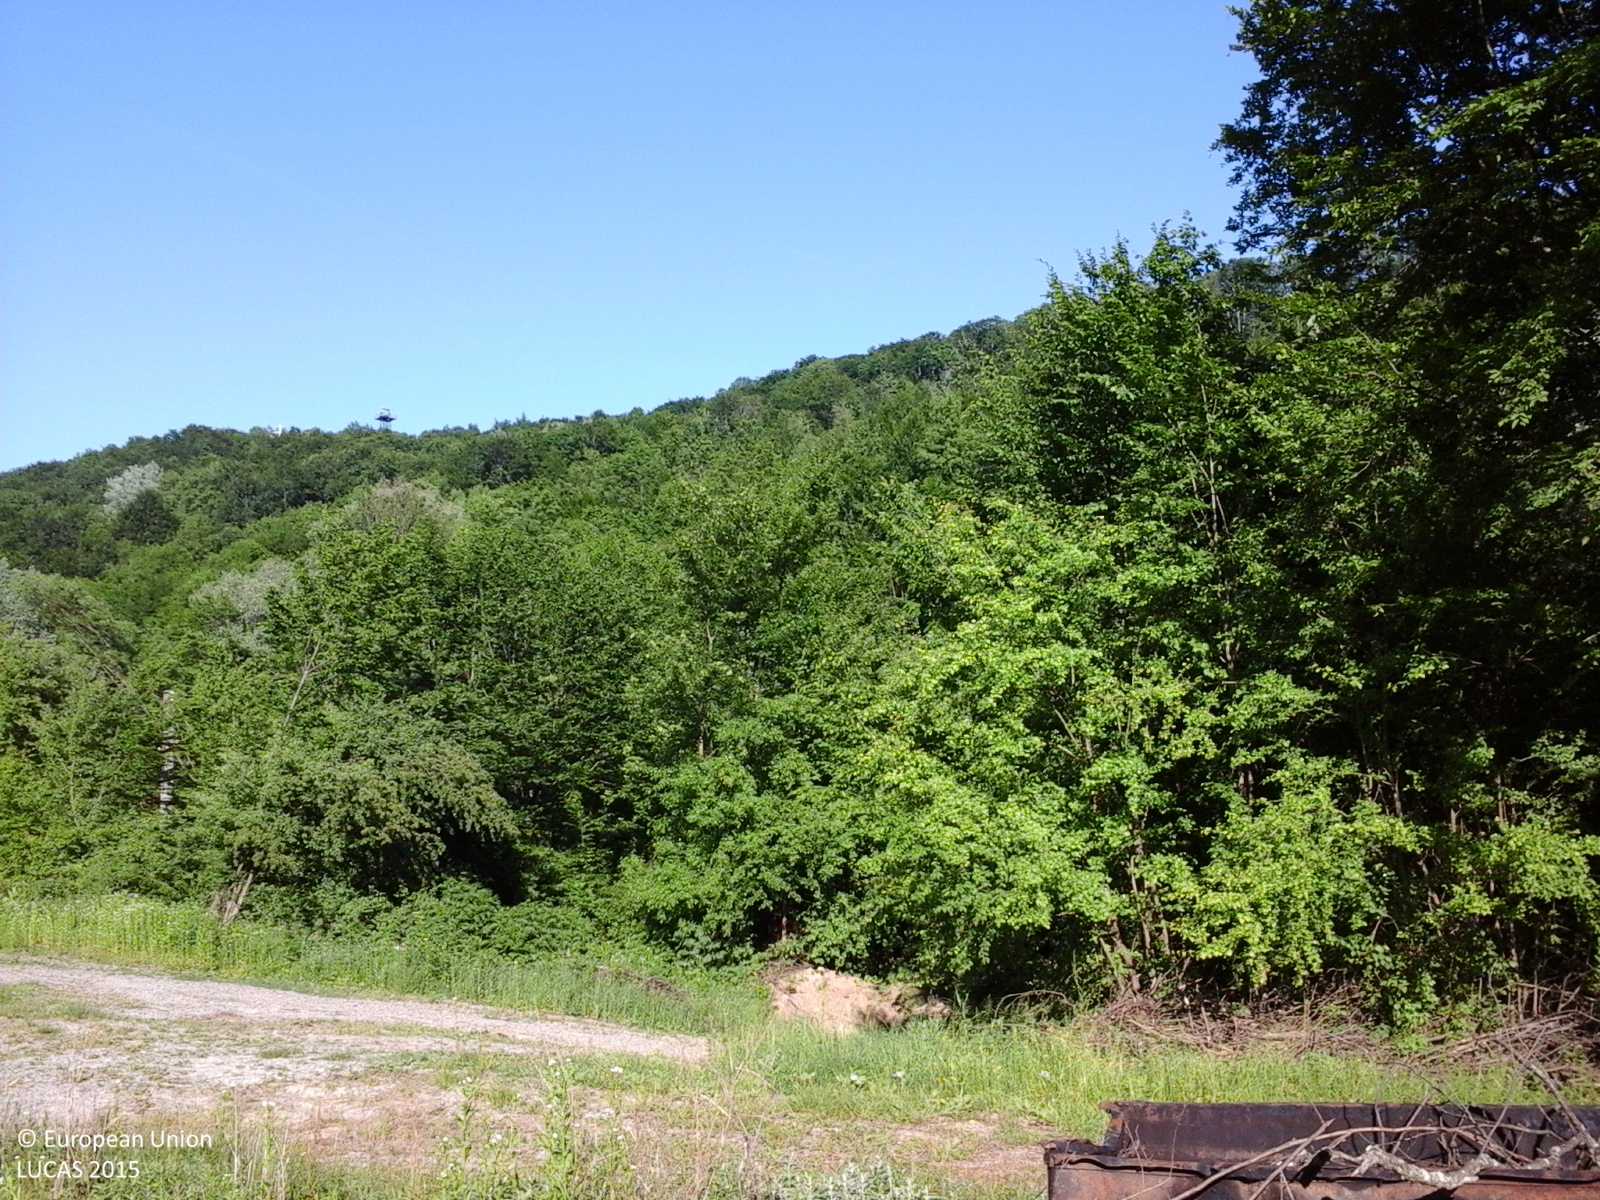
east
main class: Grassland
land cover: Spontaneously vegetated surfaces
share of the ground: > 75 %
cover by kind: herbaceous plants 100 %
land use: Forestry
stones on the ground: < 10 %
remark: Clear cut
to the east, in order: Spontaneously vegetated surfaces; Artificial constructions in urban areas; Broadleaved woodland; Electric lines; Inland fresh running water; Broadleaved woodland; Electric lines; Paved roads, cycling and walking lanes; Ditches and canals; Broadleaved woodland; Spontaneously vegetated surfaces; Broadleaved woodland
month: June
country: RO
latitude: 45.1083
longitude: 25.8271
